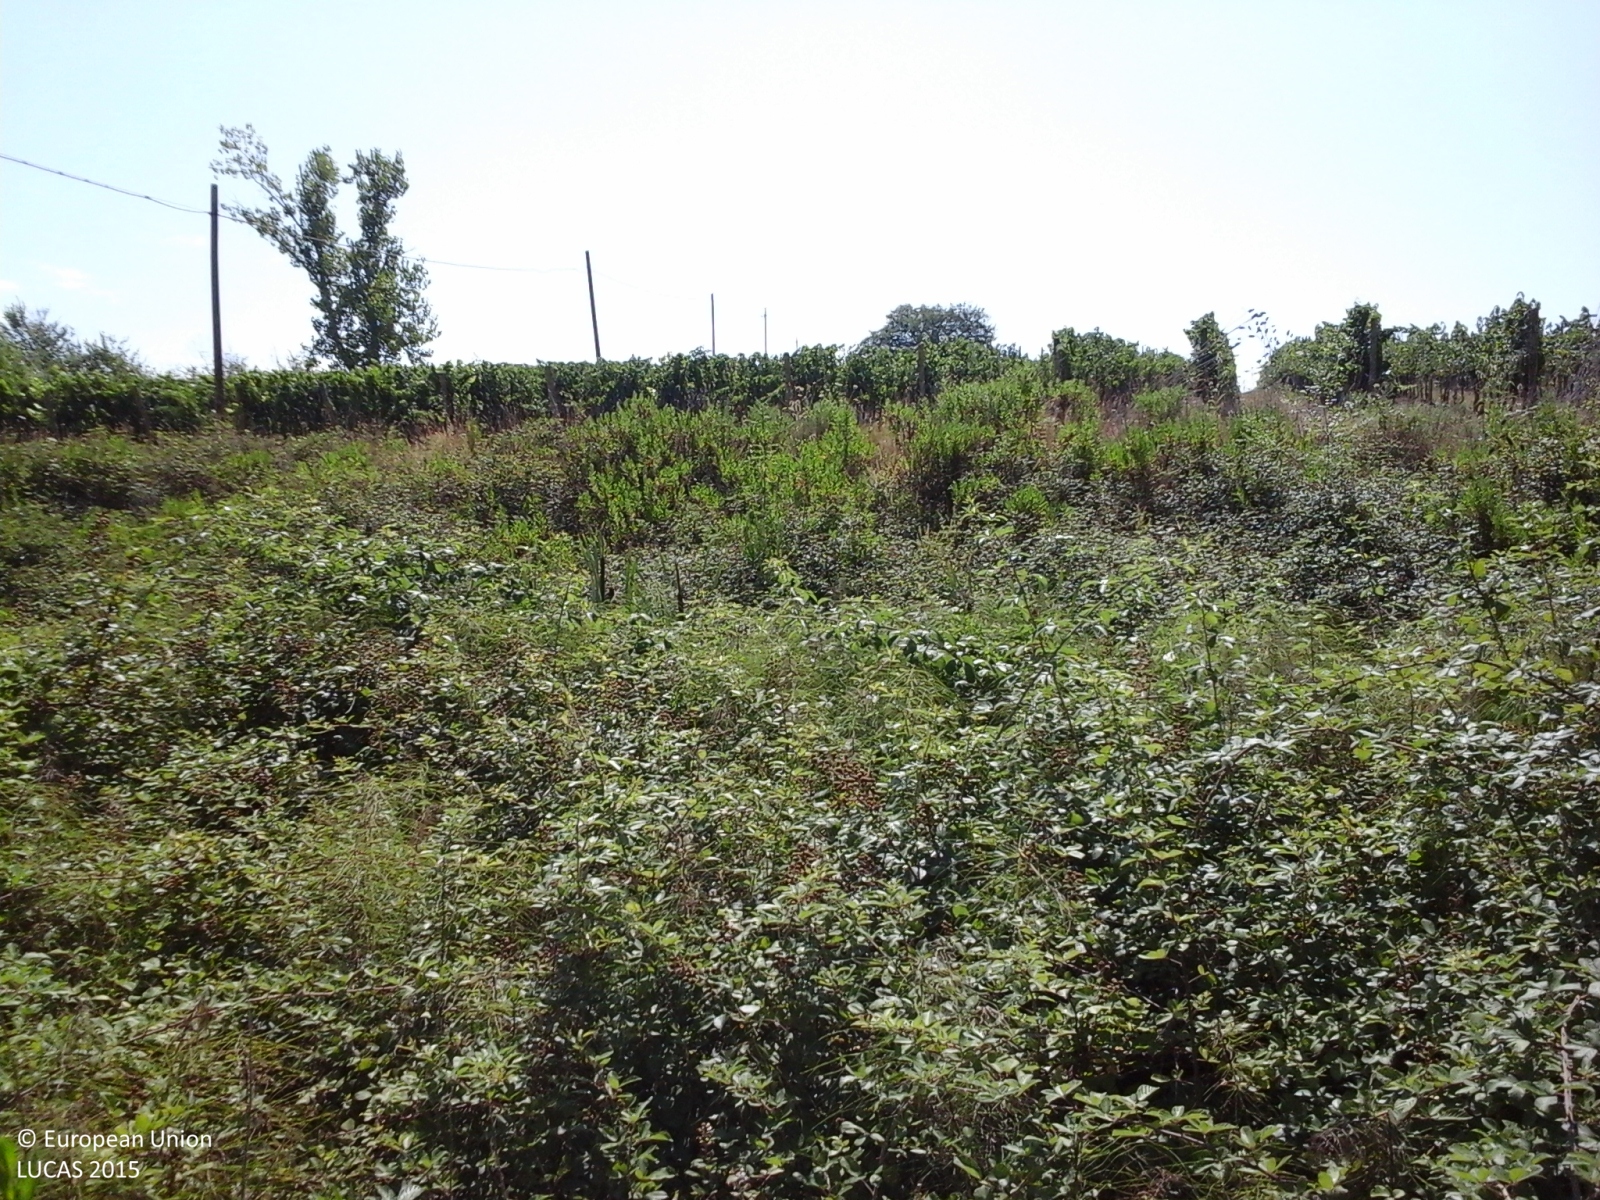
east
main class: Grassland
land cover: Spontaneously vegetated surfaces
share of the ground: > 75 %
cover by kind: herbaceous plants 85 %, shrubs 5 %, consolidated bare surface 5 %, unconsolidated bare surface 5 %
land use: Abandoned areas
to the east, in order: Spontaneously vegetated surfaces; Ditches and canals; Grass margins; Tracks; Vineyards; Abandoned hedges; Paved roads, cycling and walking lanes; Grass margins; Ponds and wetlands; Vineyards; Tracks; Grass margins; Paved roads, cycling and walking lanes
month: July
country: IT
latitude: 42.9735
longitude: 11.0634
